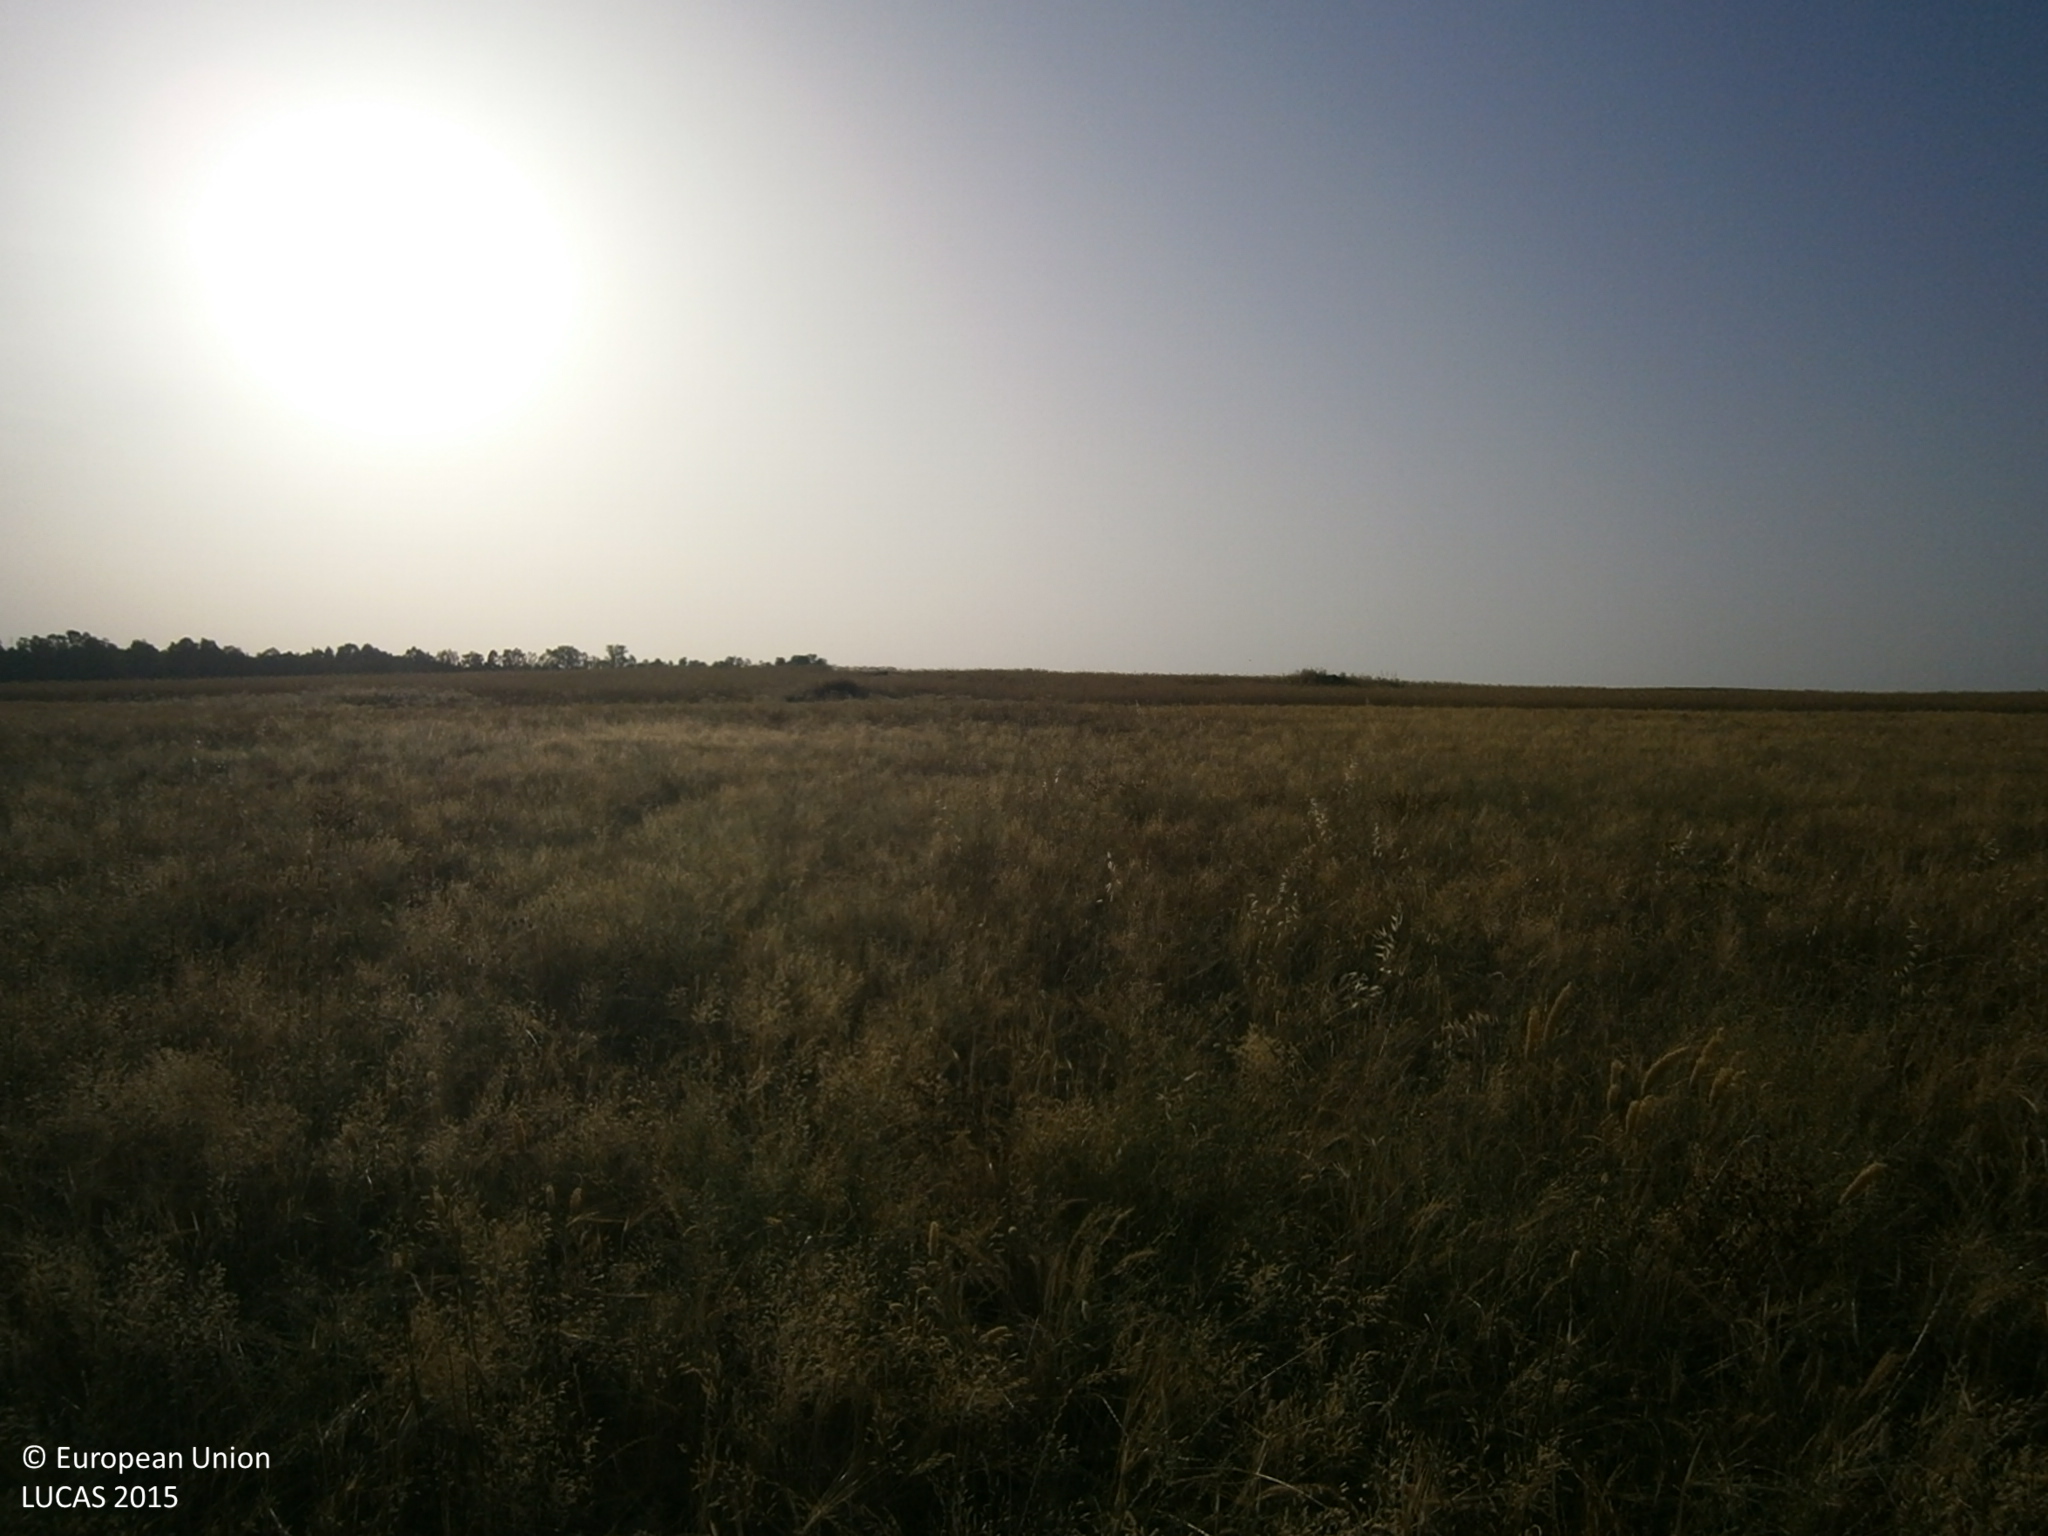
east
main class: Grassland
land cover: Grassland without tree/shrub cover
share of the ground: > 75 %
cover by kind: herbaceous plants 100 %
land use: Agriculture (excluding fallow land and kitchen gardens)
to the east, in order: Grassland without tree/shrub cover; Durum wheat; Grassland without tree/shrub cover; Durum wheat; Tracks; Barley
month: June
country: ES
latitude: 38.9013
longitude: -6.2563
